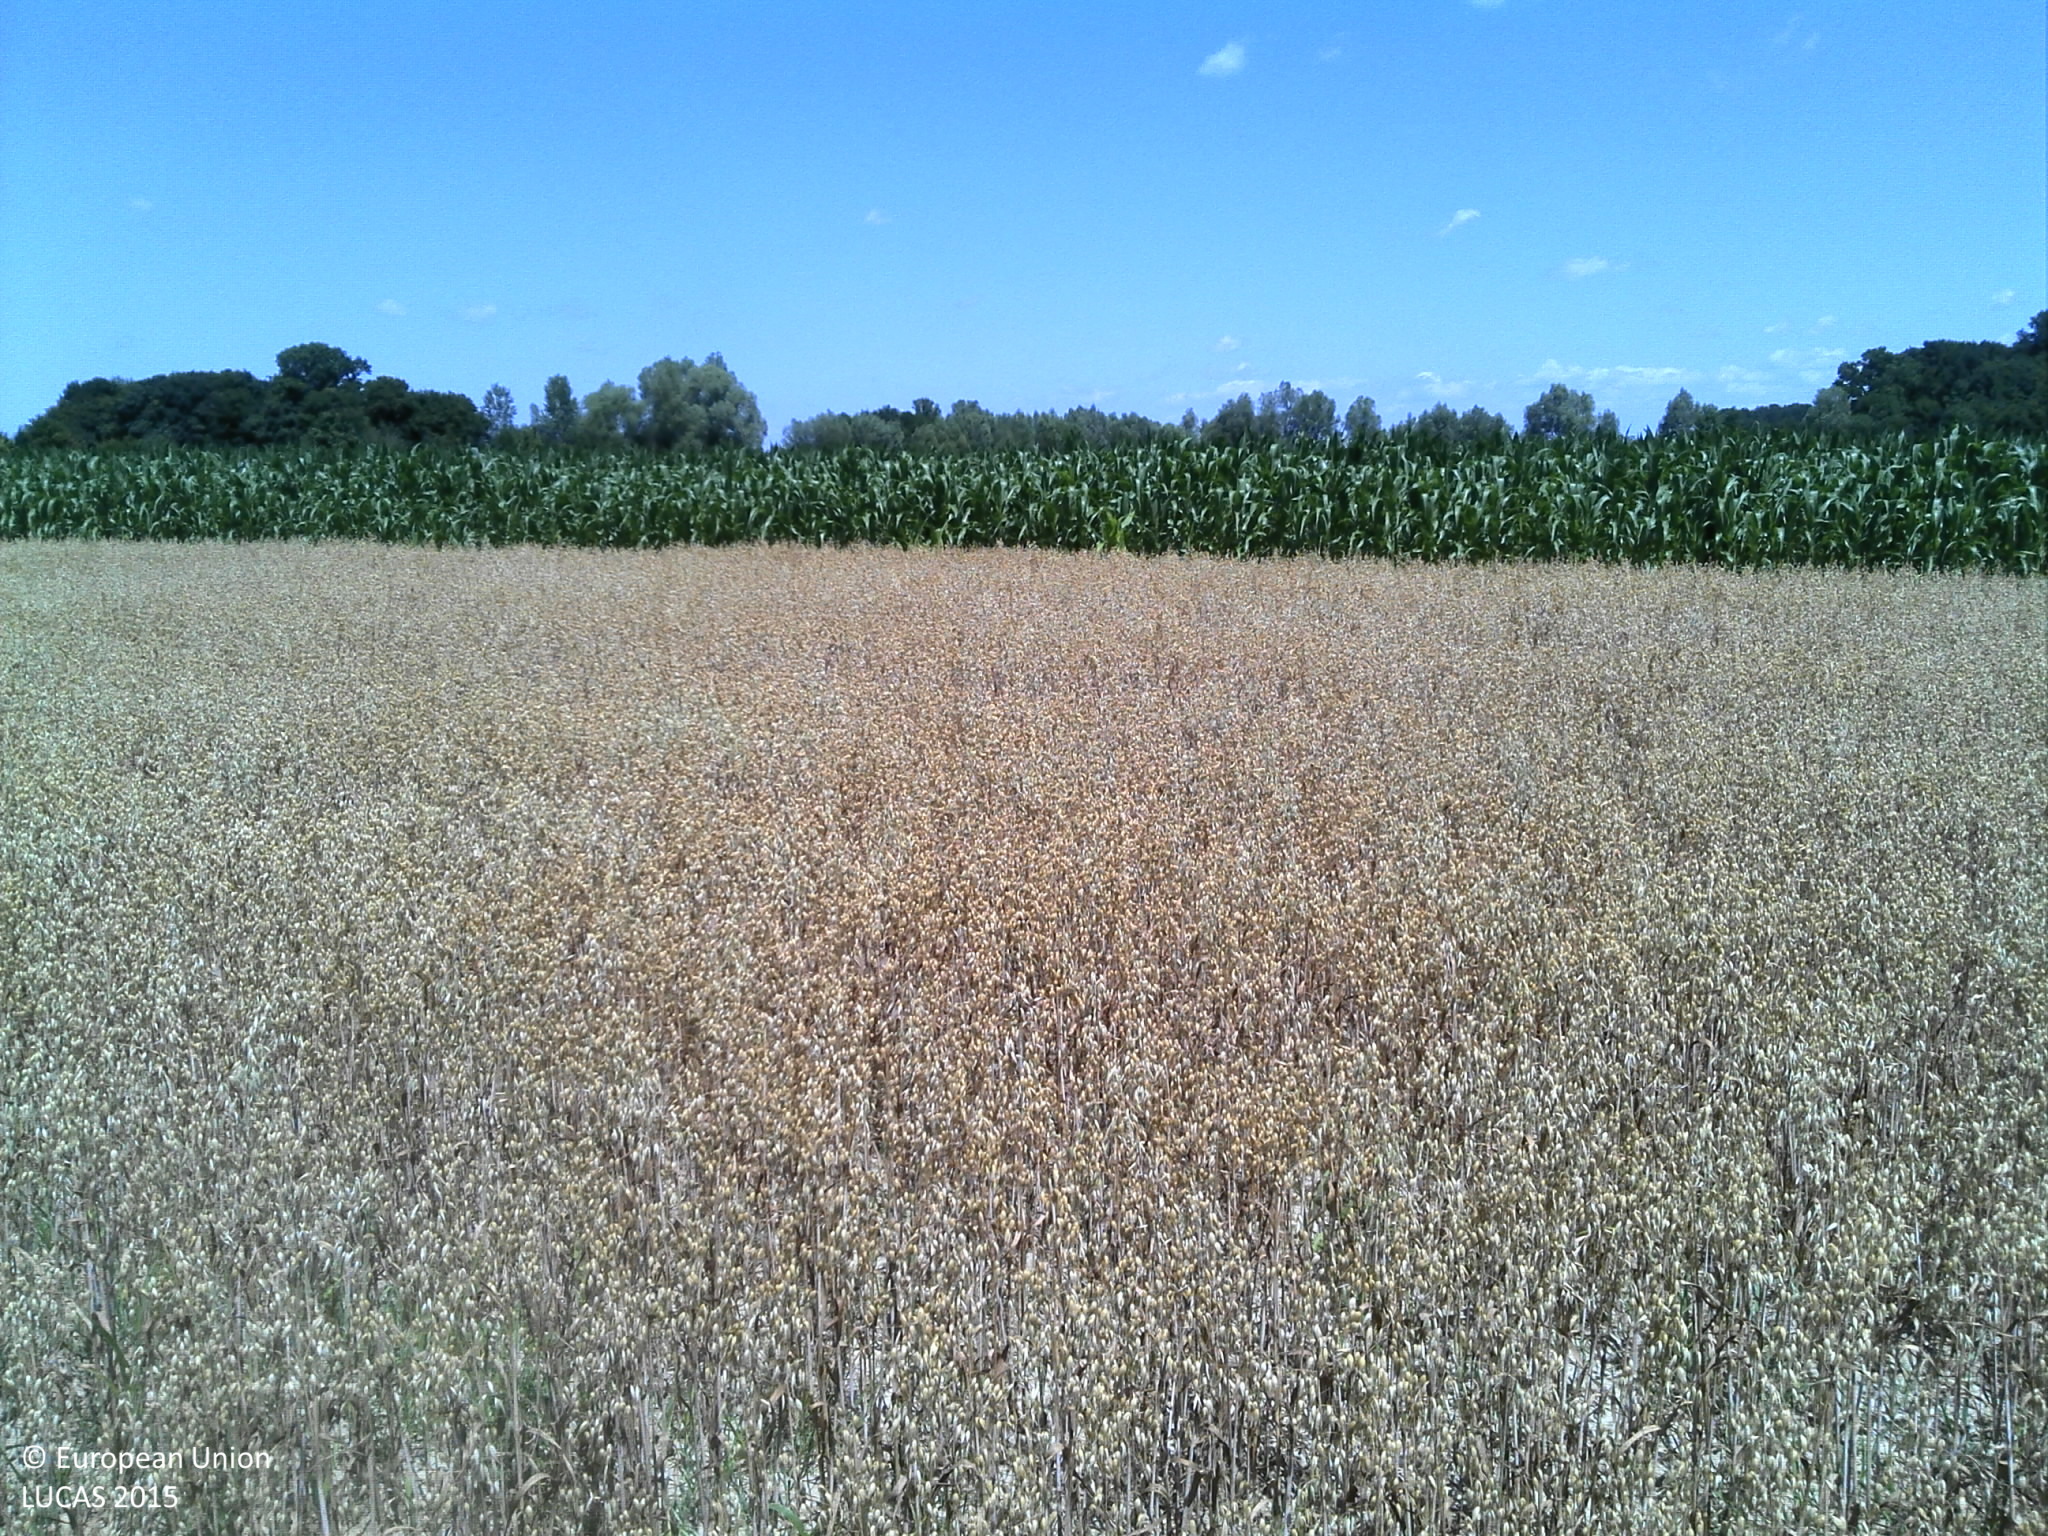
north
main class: Cropland
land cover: Oats
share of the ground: > 75 %
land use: Agriculture (excluding fallow land and kitchen gardens)
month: July
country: HR
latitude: 45.8023
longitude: 16.9098
